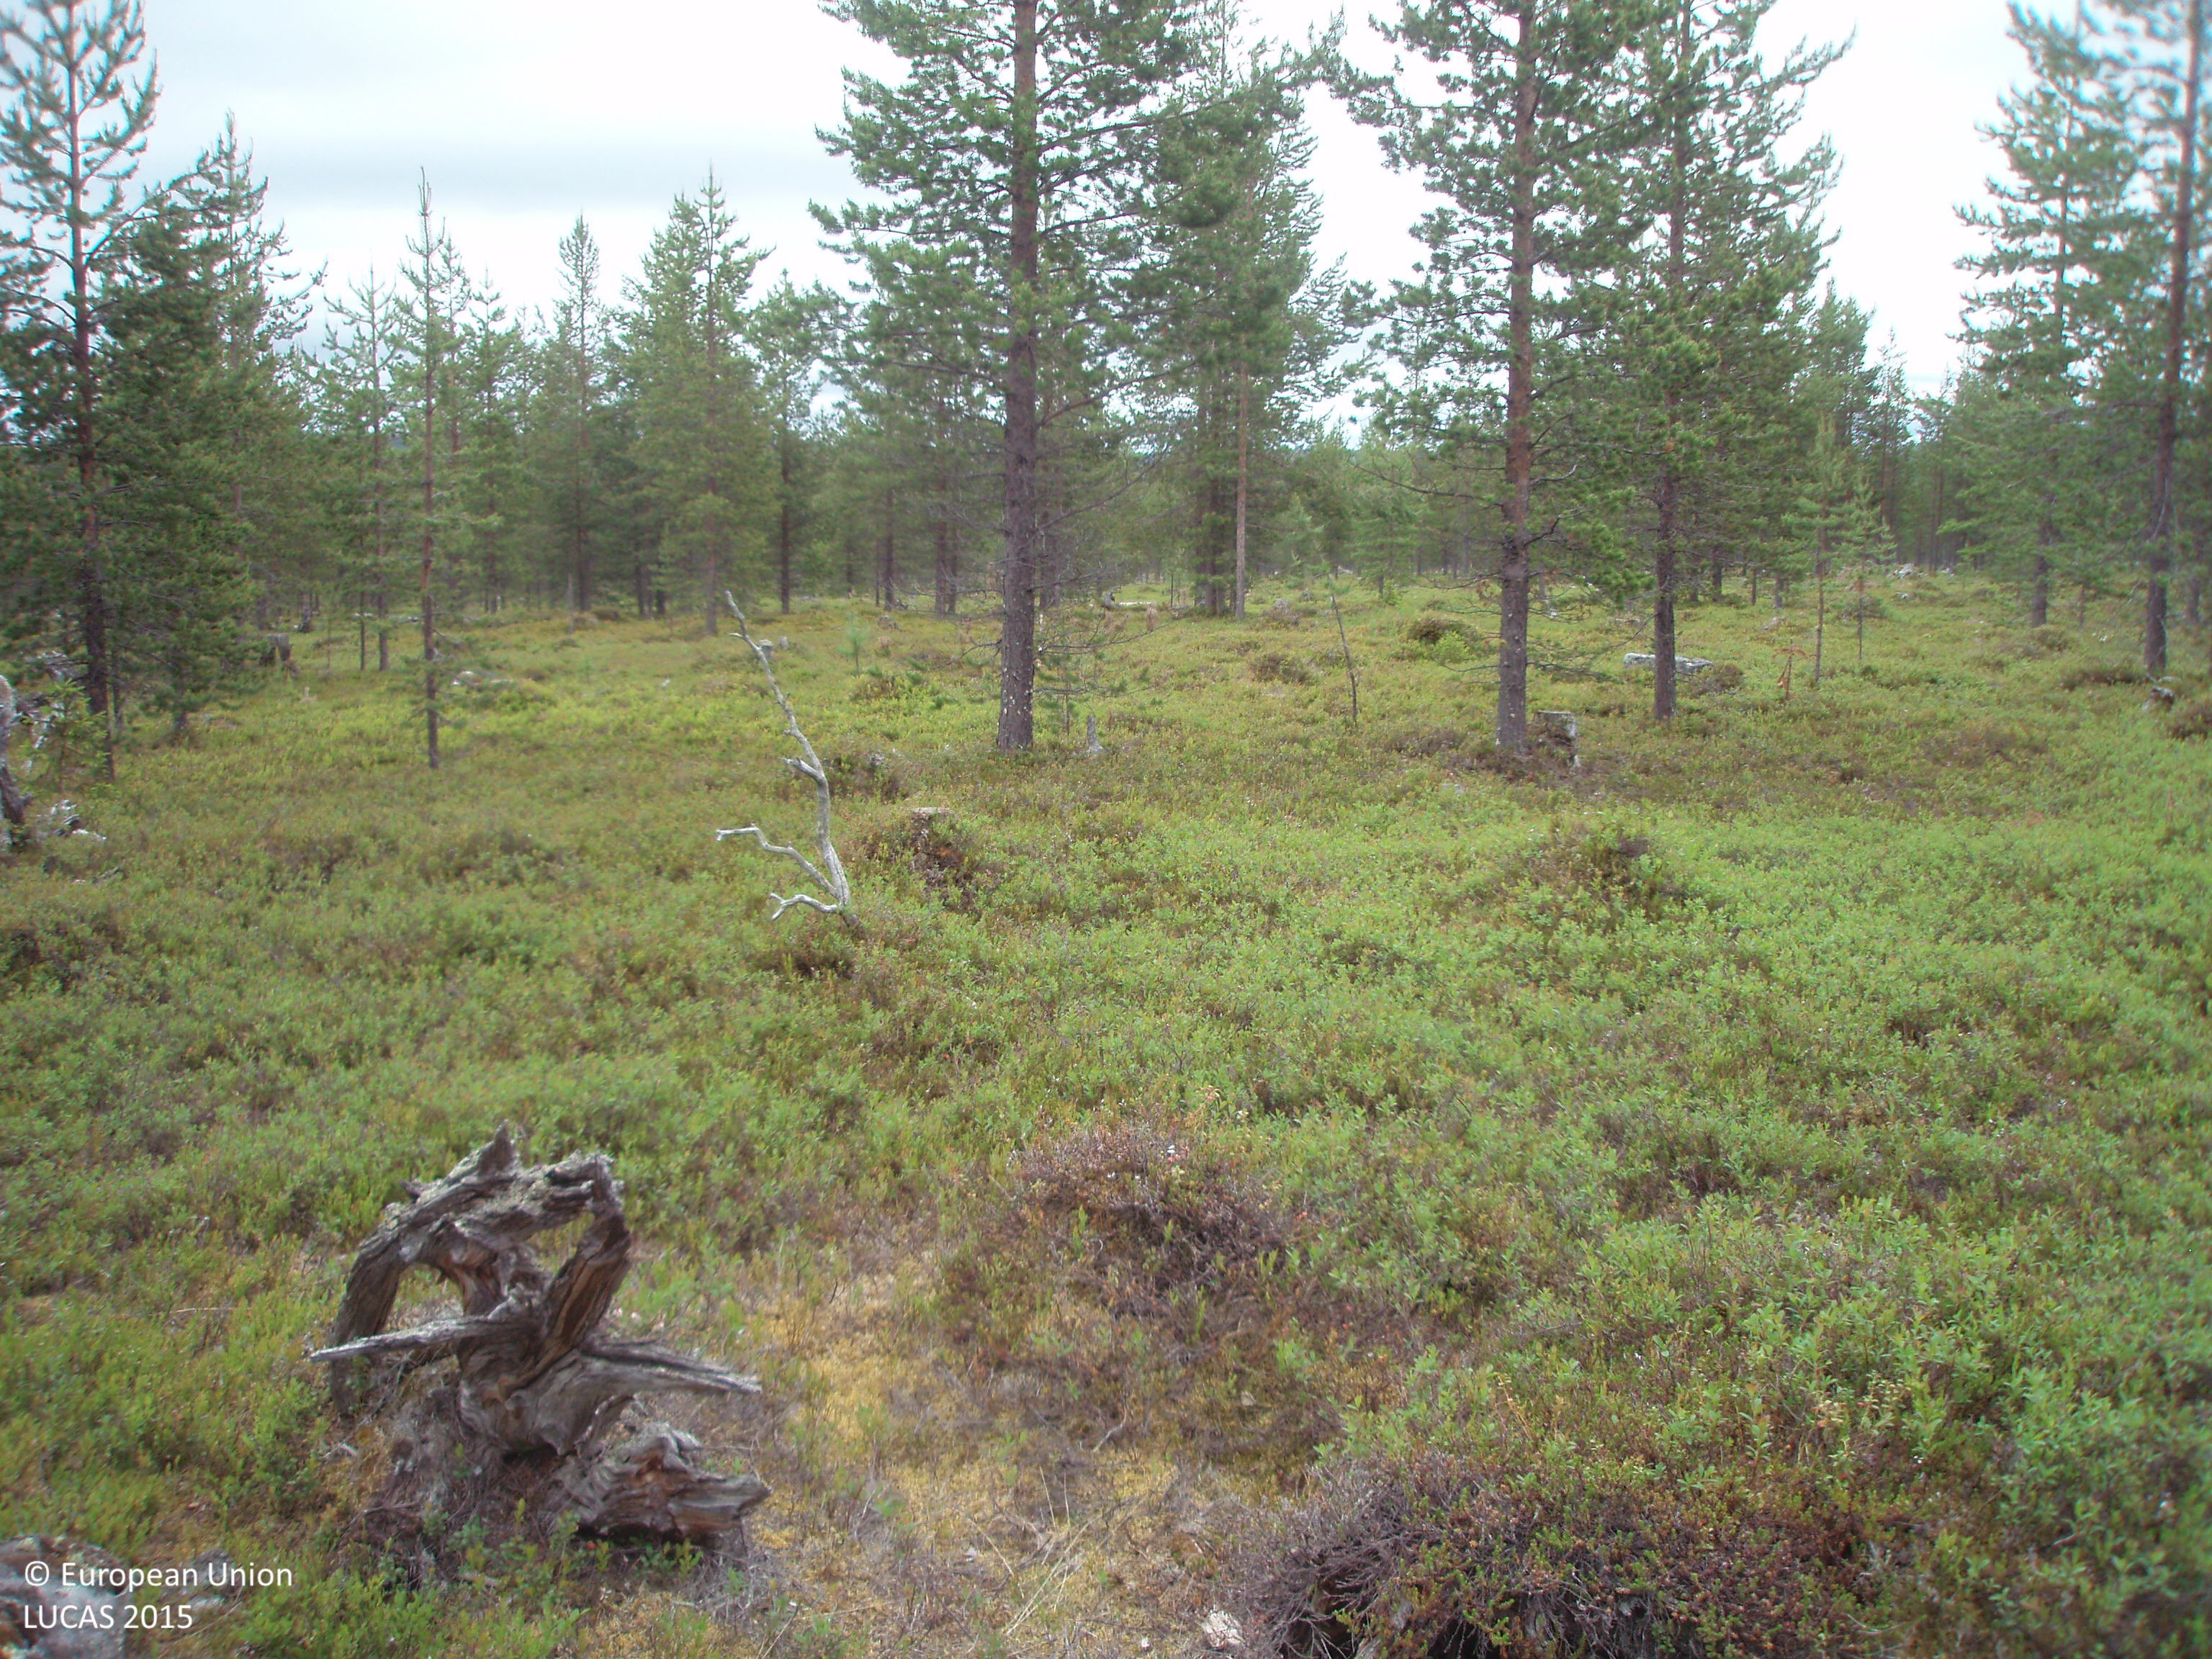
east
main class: Woodland
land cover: Pine dominated coniferous woodland
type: boreal forest
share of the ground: 50 - 75 %
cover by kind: coniferous forest trees 50 %, shrubs 50 %
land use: Forestry
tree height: > 5 m
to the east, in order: Pine dominated coniferous woodland
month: July
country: FI
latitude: 67.7229
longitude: 28.9316
